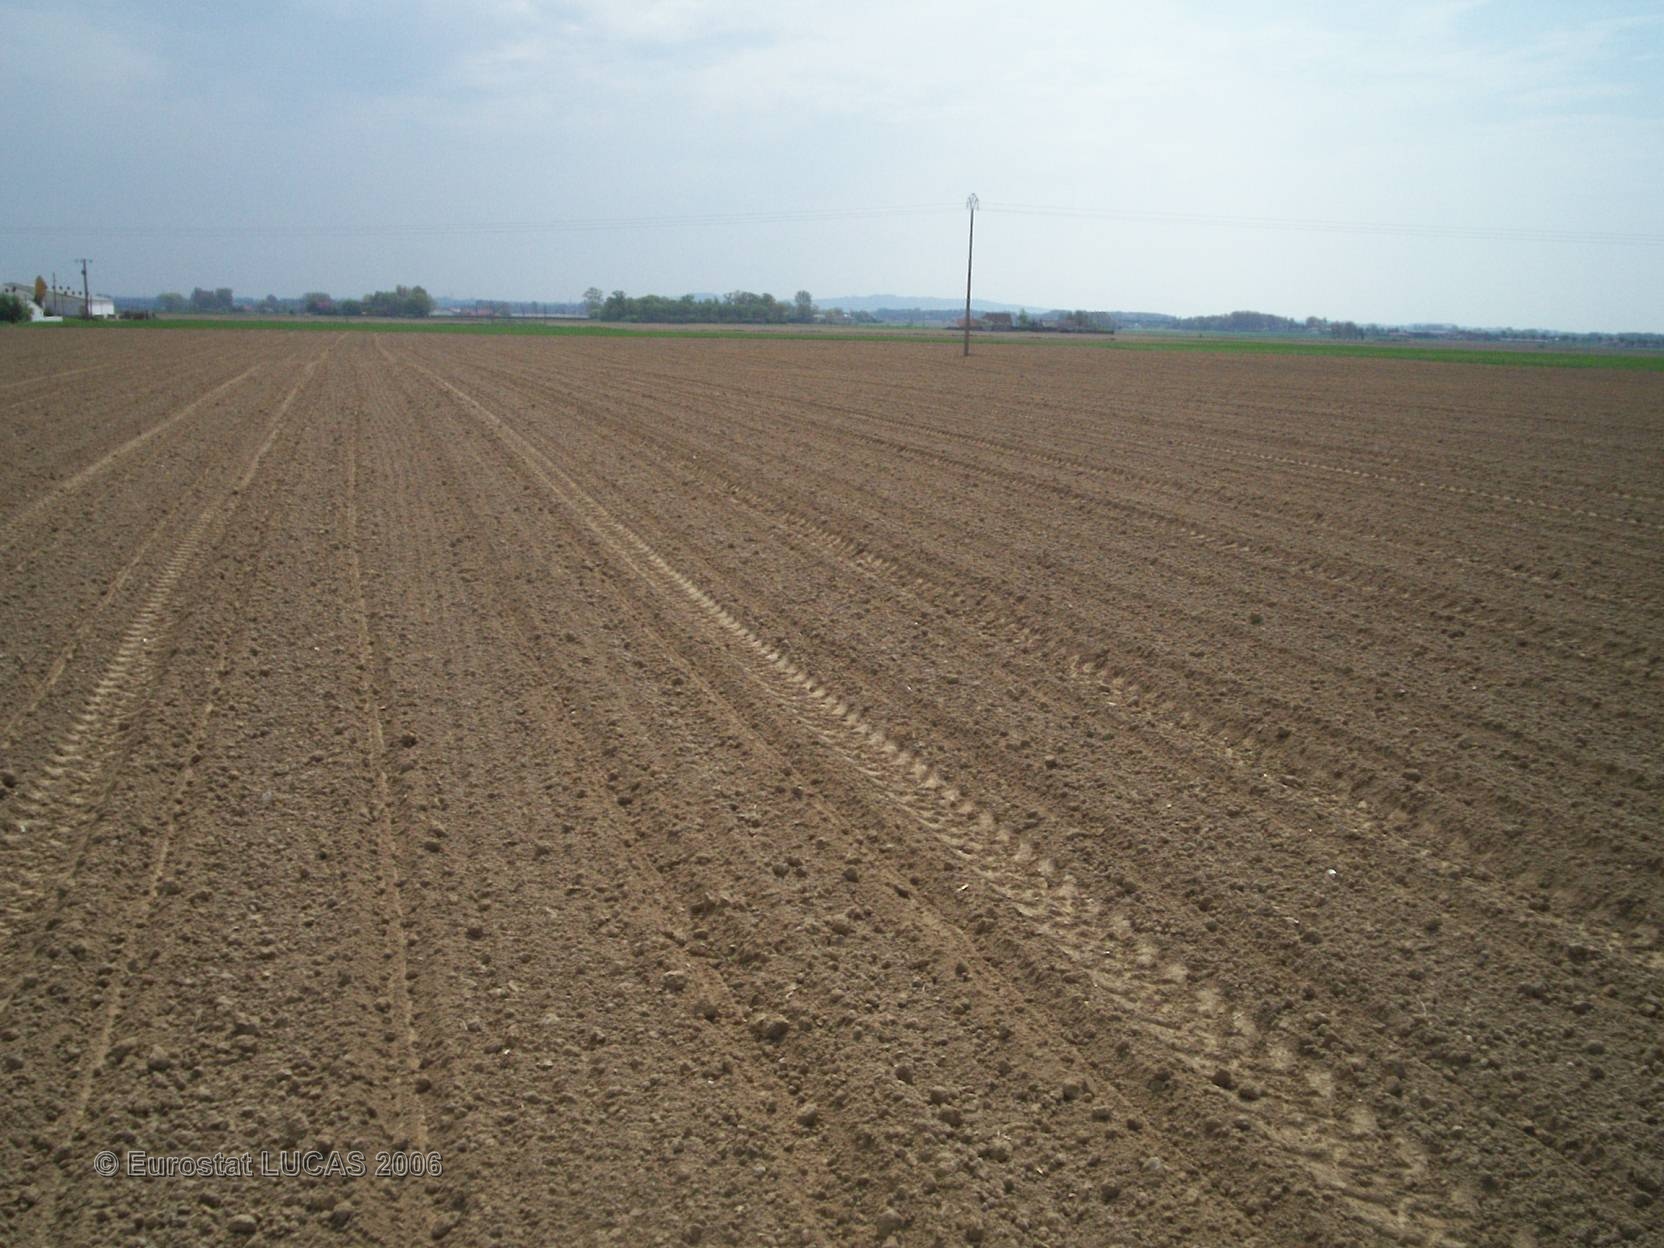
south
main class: Cropland
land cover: Maize
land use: Agriculture (excluding fallow land and kitchen gardens)
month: May
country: FR
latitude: 50.9277
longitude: 2.4606
